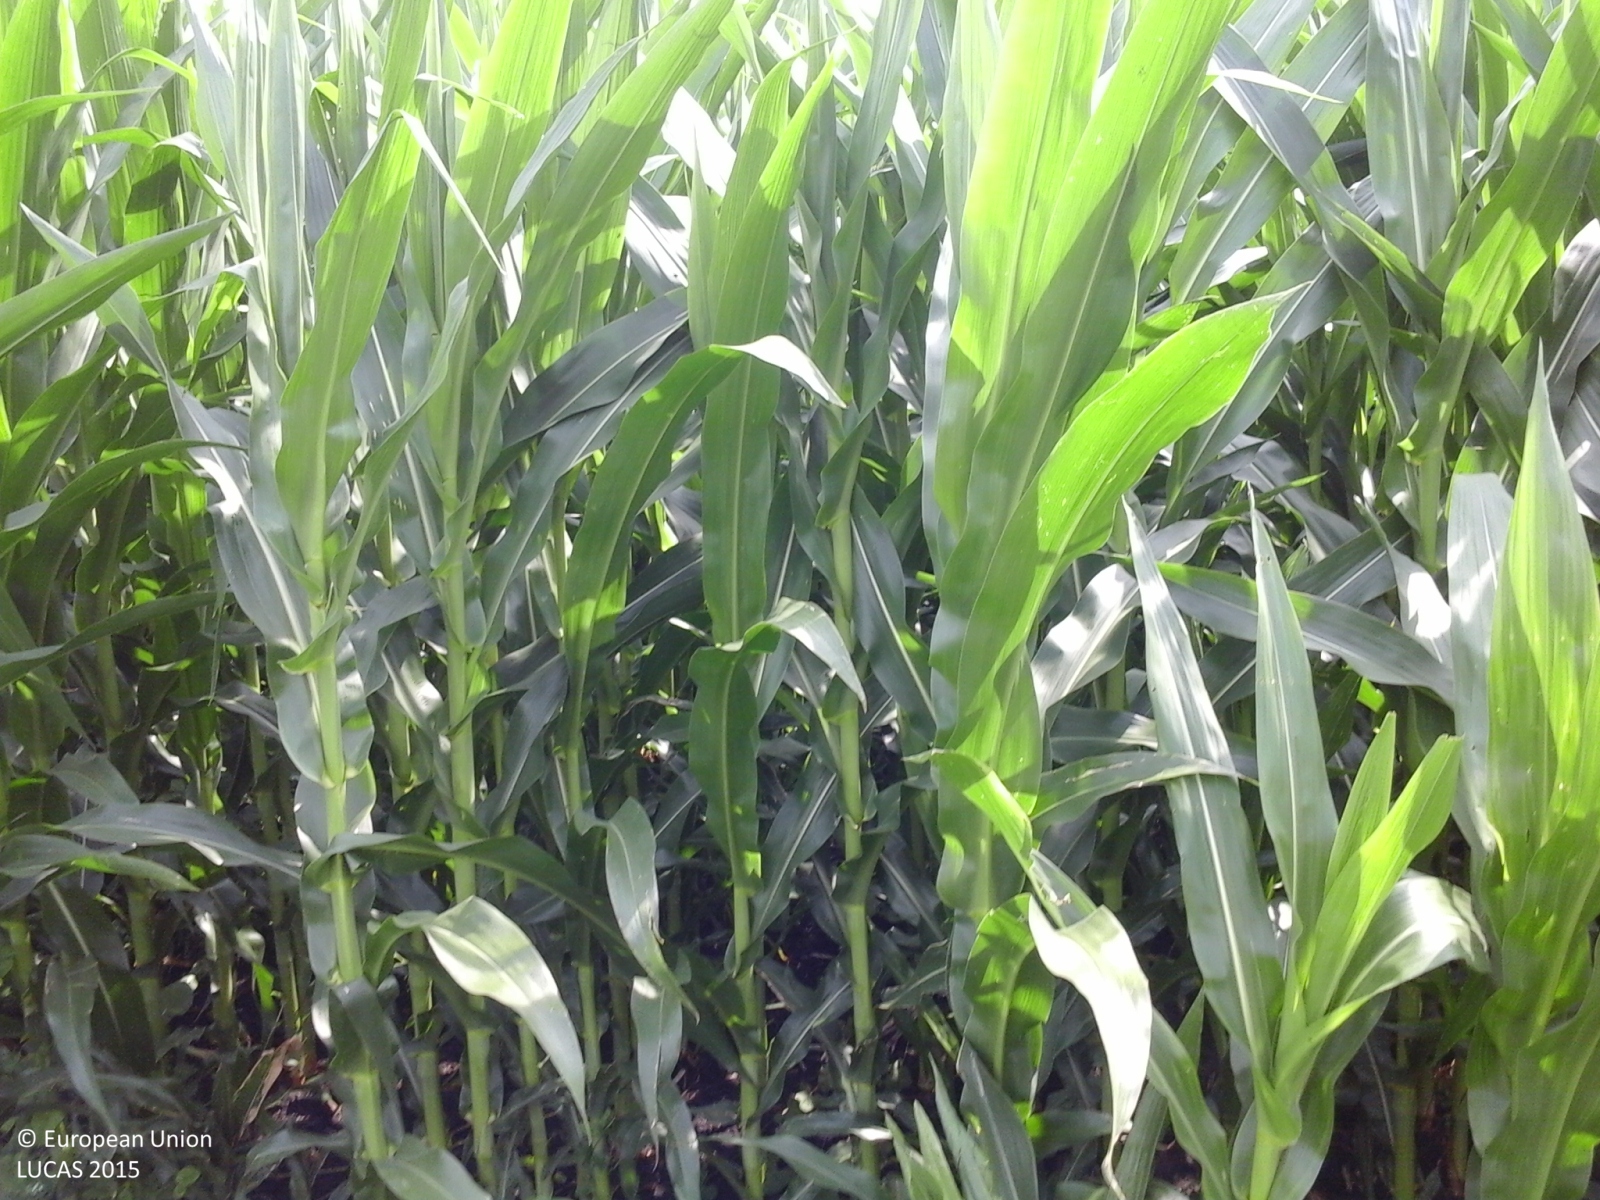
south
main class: Cropland
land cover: Maize
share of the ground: > 75 %
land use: Agriculture (excluding fallow land and kitchen gardens)
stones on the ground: < 10 %
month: June
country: IT
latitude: 45.9265
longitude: 12.4598
